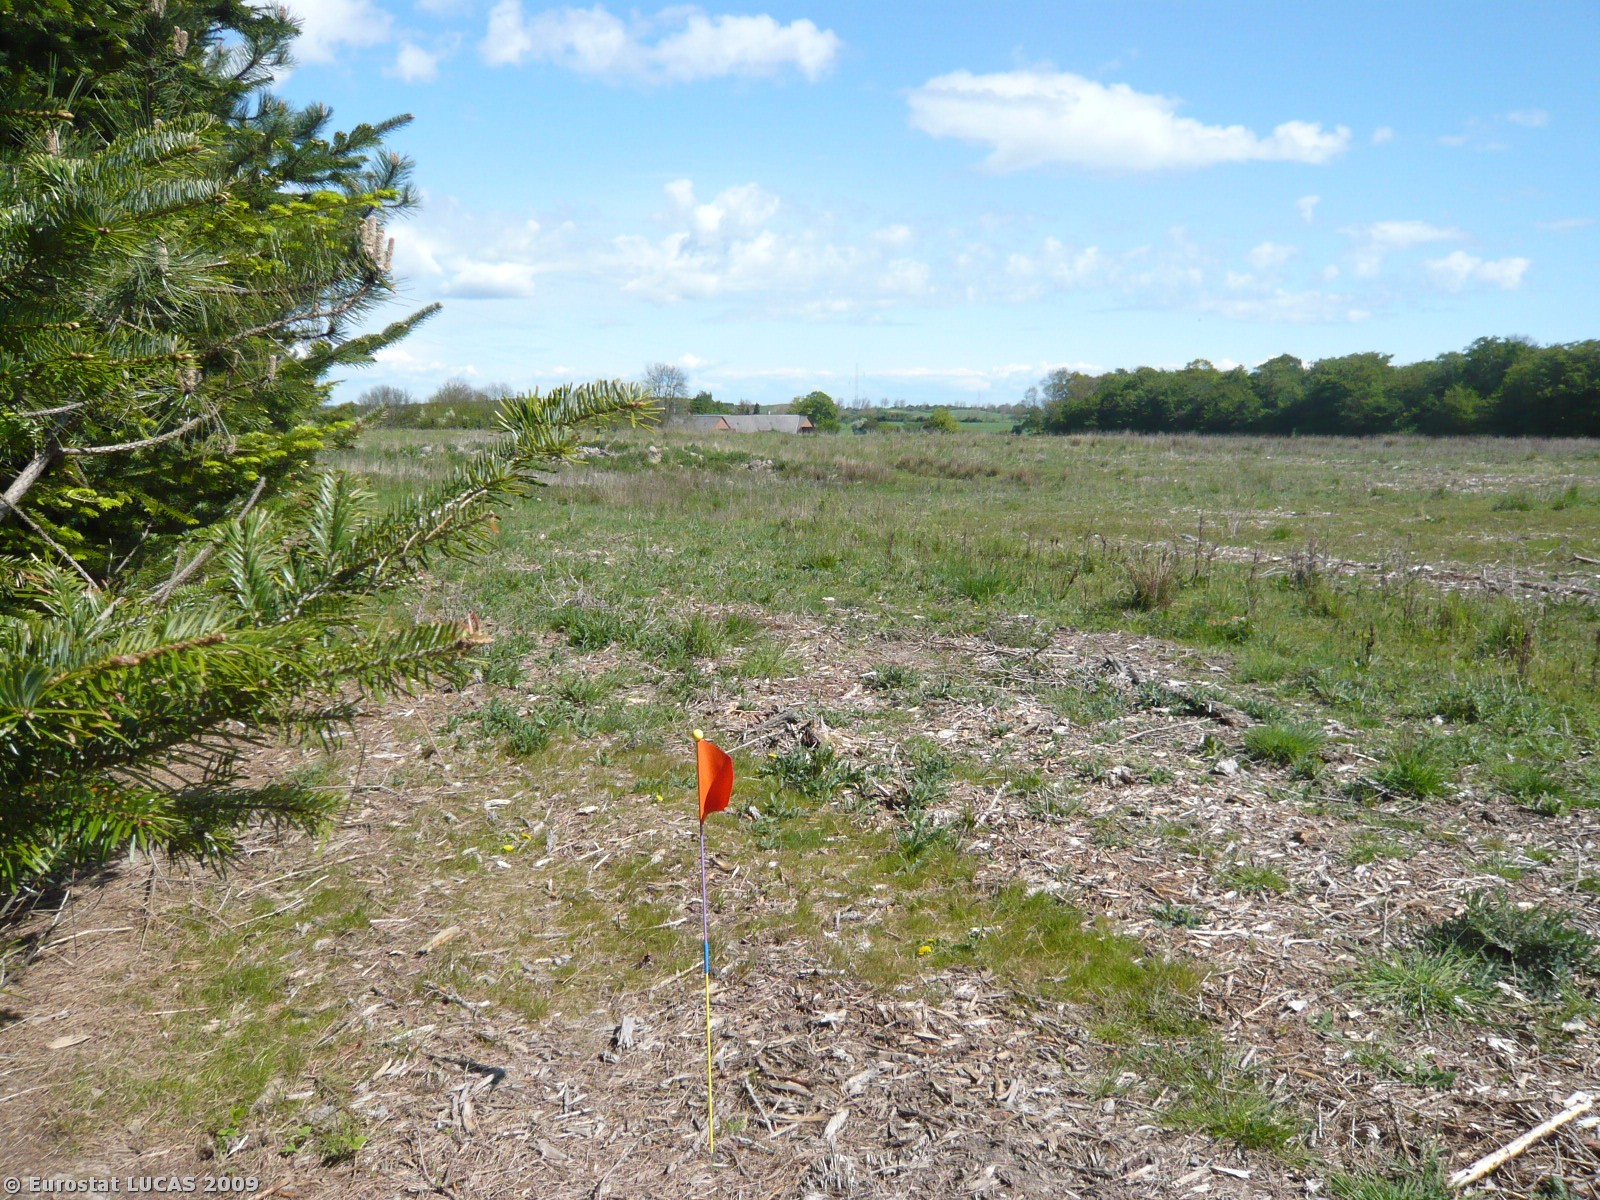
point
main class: Grassland
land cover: Spontaneously vegetated surfaces
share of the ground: 10 - 25 %
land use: Forestry
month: May
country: DK
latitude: 55.0756
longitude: 11.9878
